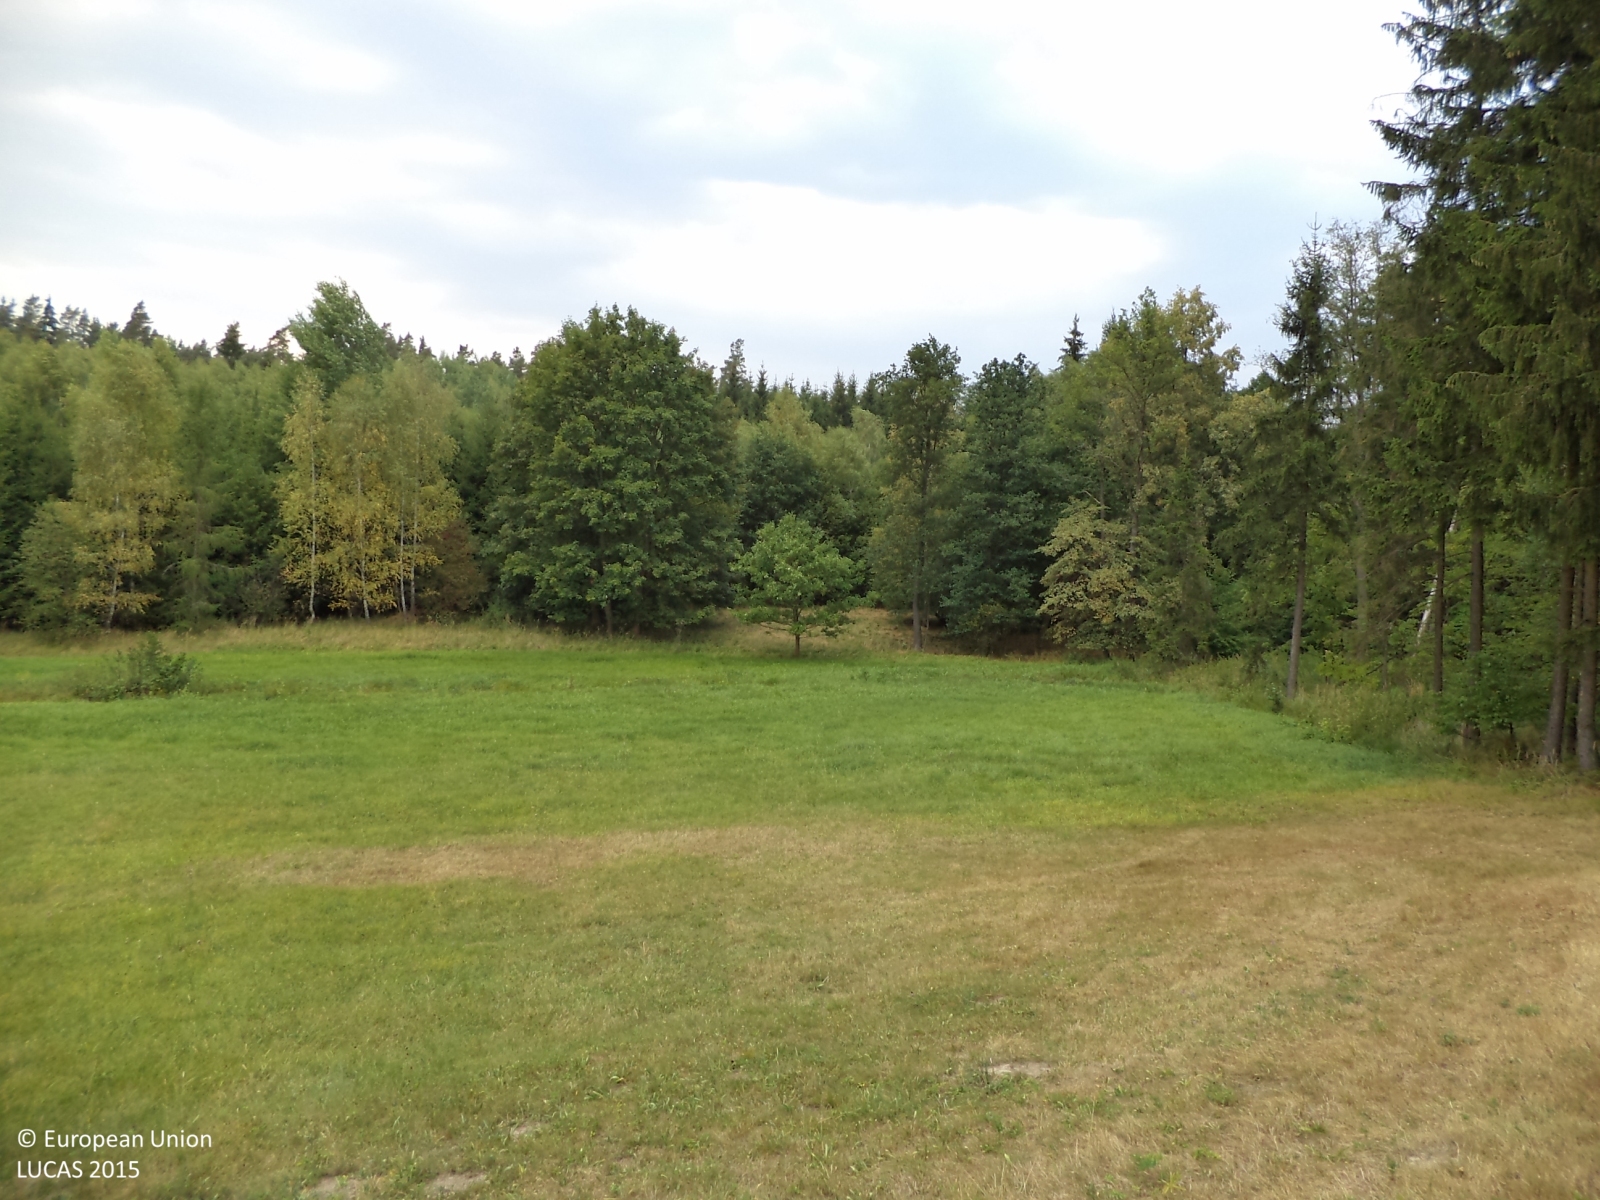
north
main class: Grassland
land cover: Grassland without tree/shrub cover
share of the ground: > 75 %
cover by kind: herbaceous plants 100 %
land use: Agriculture (excluding fallow land and kitchen gardens)
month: August
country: CZ
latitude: 49.4699
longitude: 14.3757
